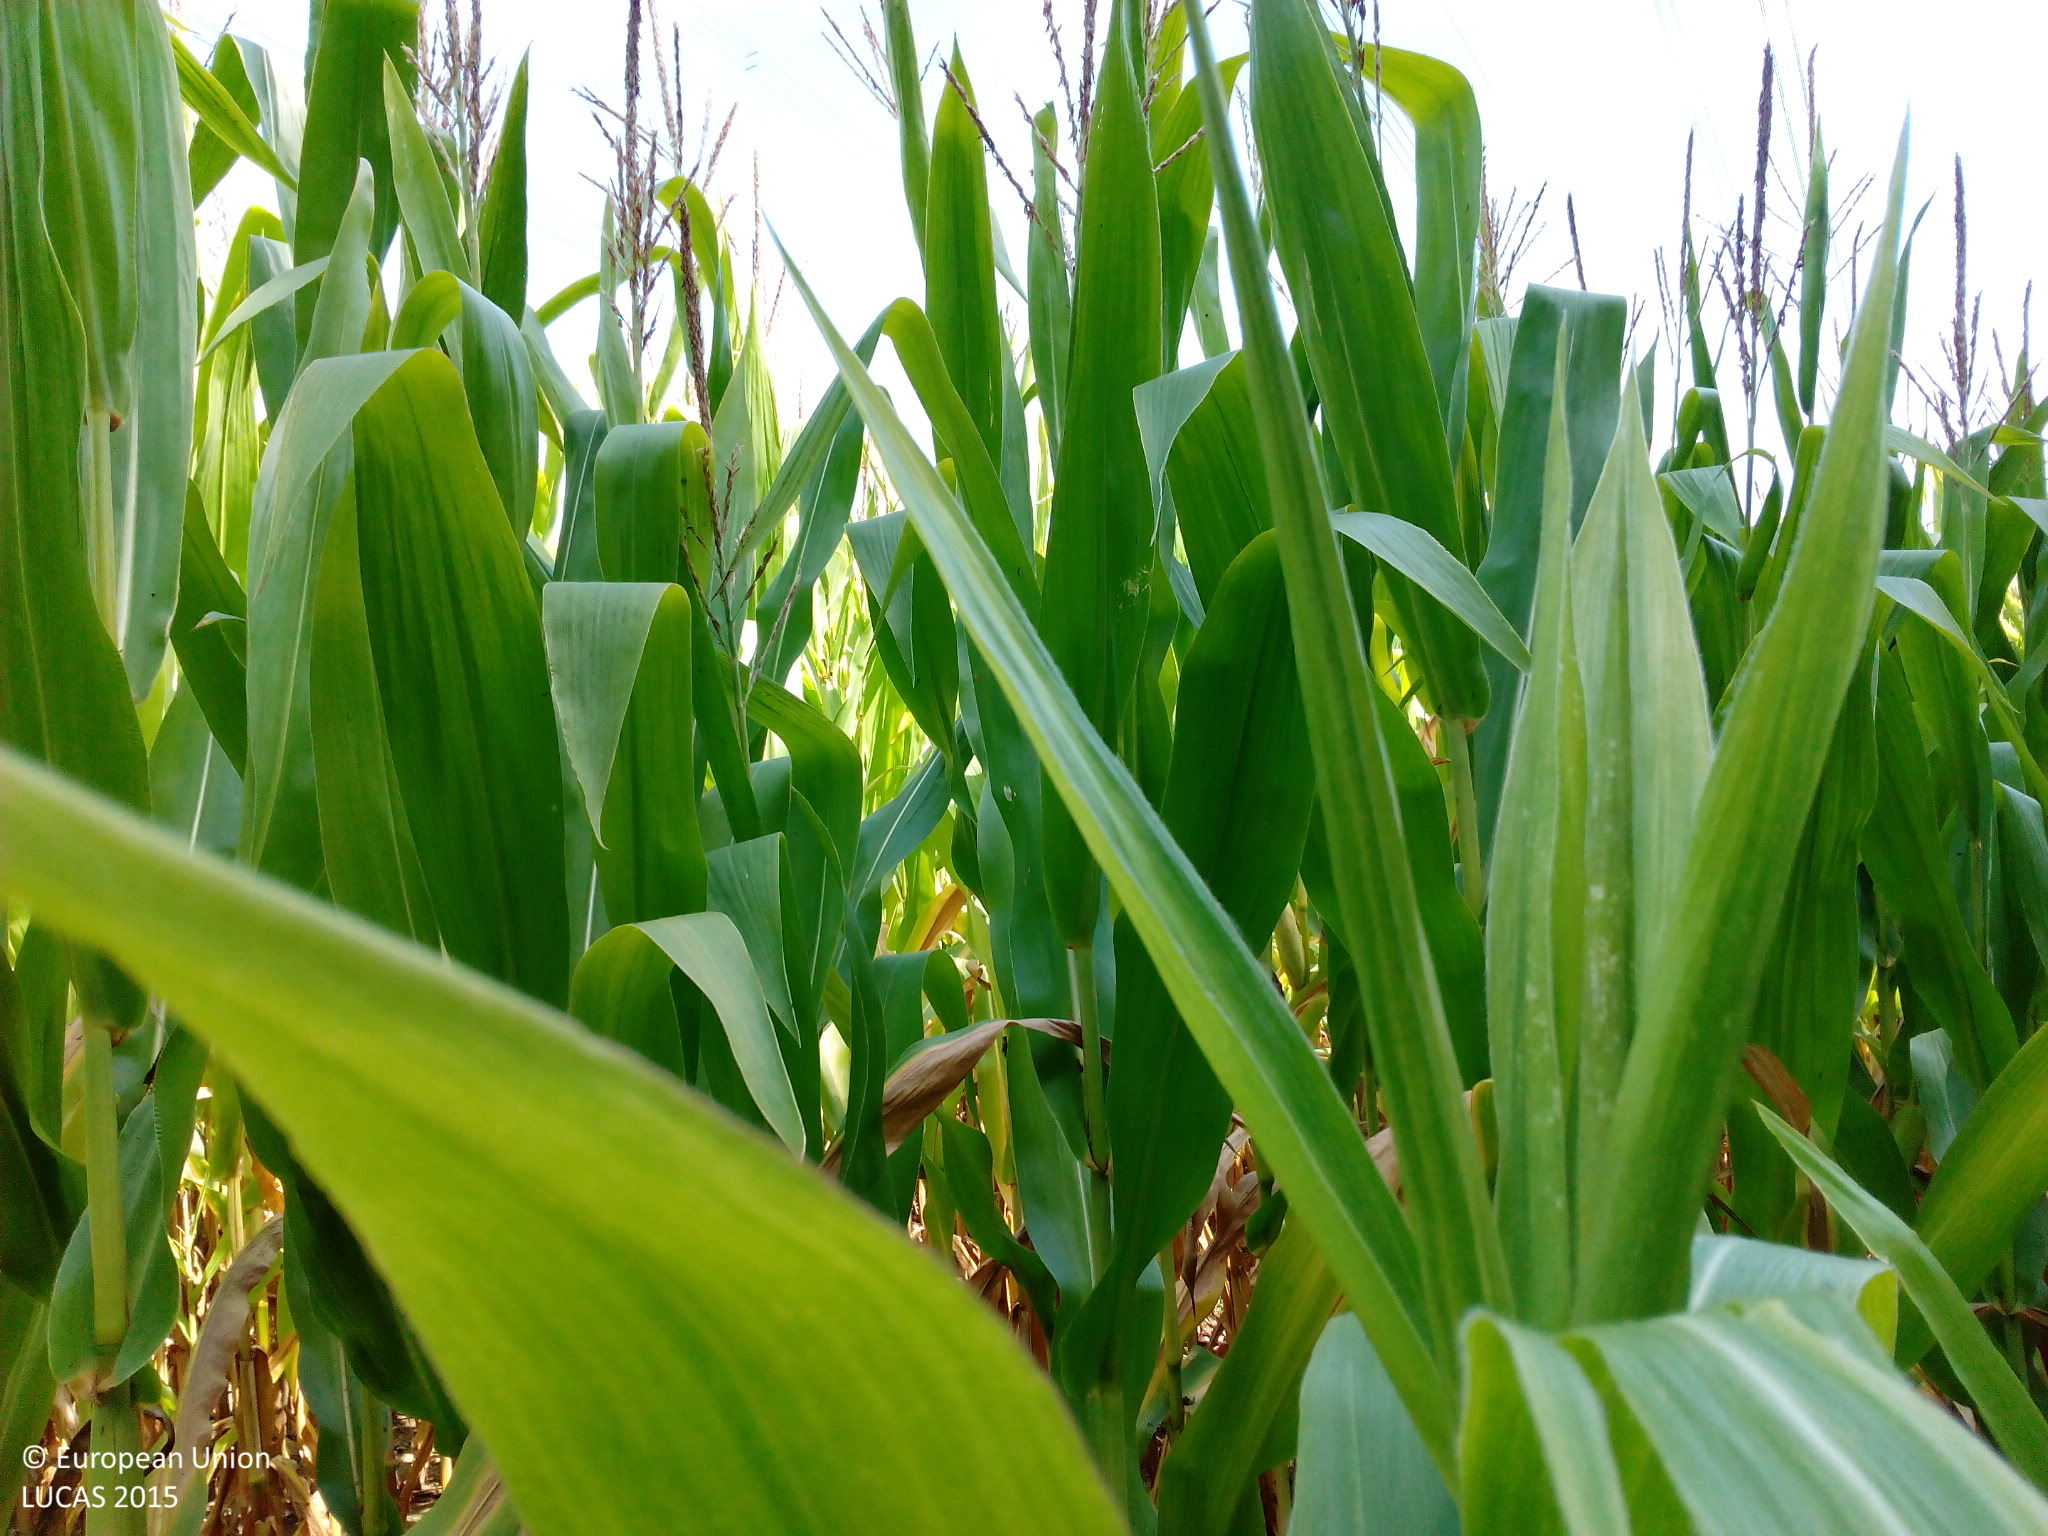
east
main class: Cropland
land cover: Maize
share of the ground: > 75 %
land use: Agriculture (excluding fallow land and kitchen gardens)
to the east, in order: Maize; Electric lines; Maize
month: August
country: DE
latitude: 48.2775
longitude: 9.9327
